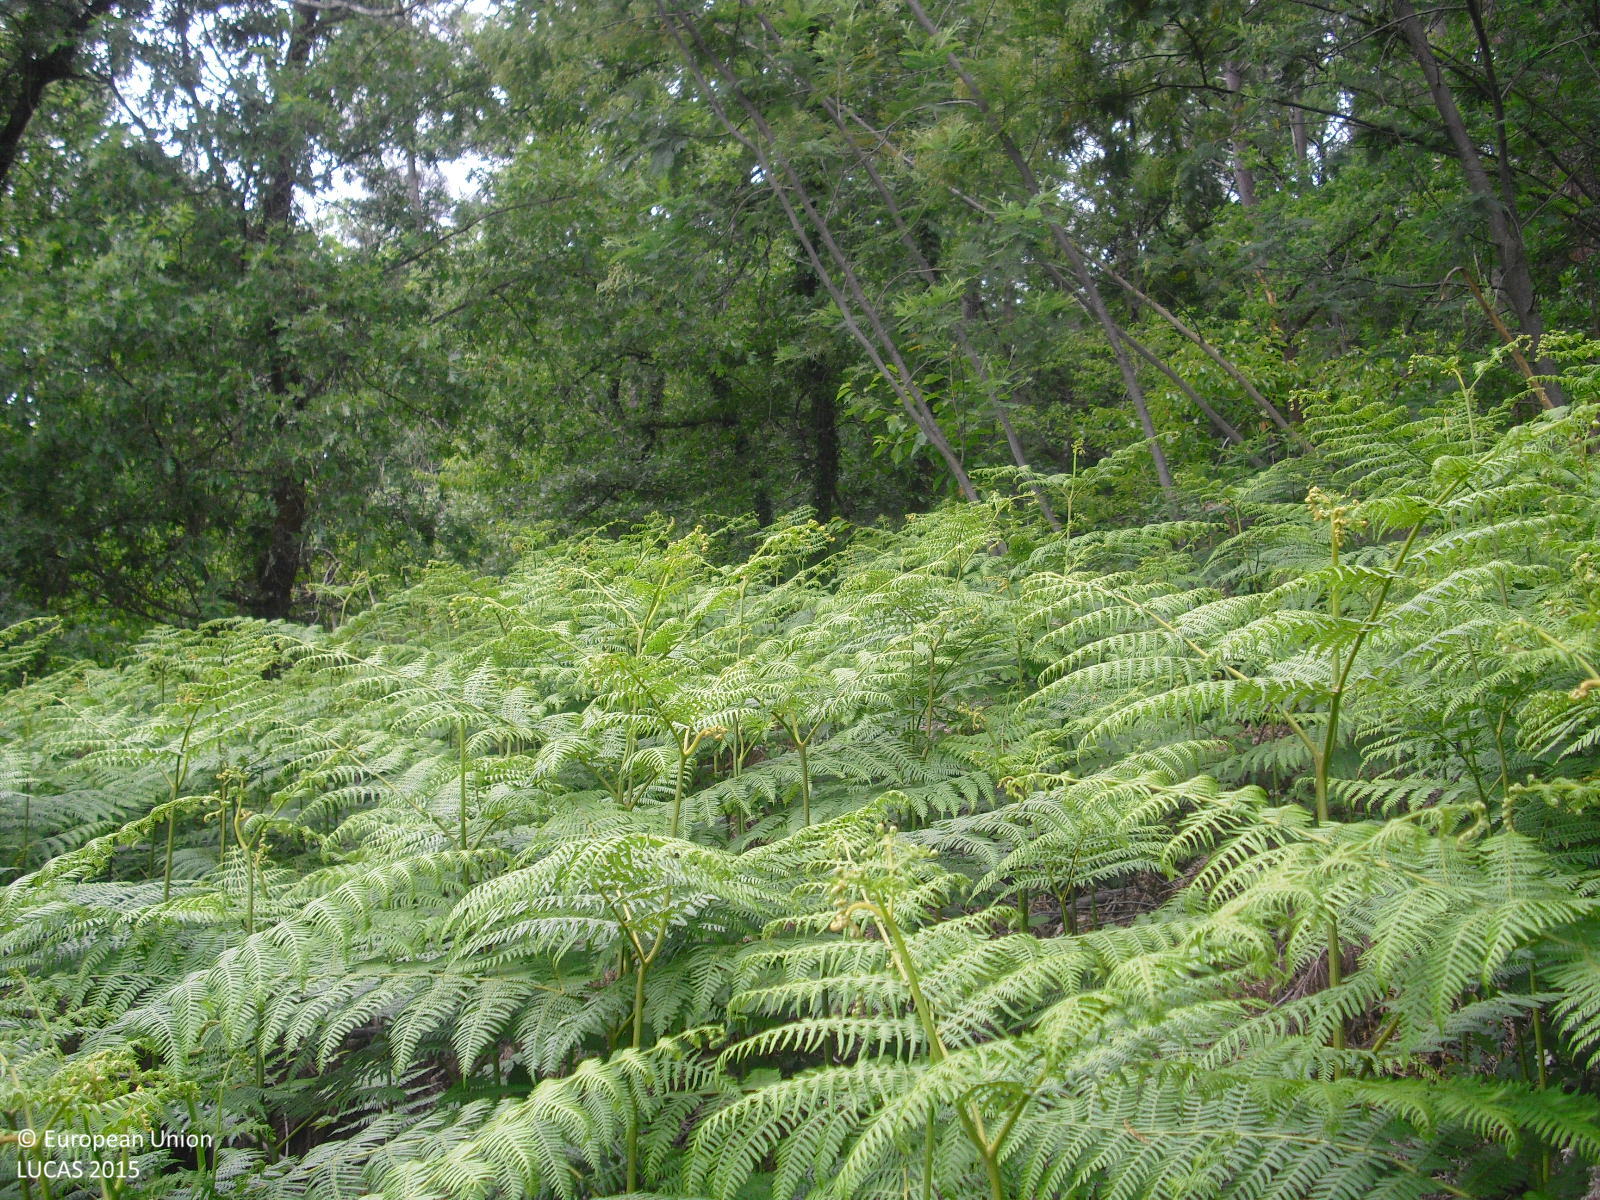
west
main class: Woodland
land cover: Broadleaved woodland
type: acidophilous oak and oak-birch forest
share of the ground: 25 - 50 %
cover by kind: shrubs 60 %, broadleaved forest trees 40 %
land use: Forestry
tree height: > 5 m
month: May
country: ES
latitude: 42.1992
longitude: -7.9406
